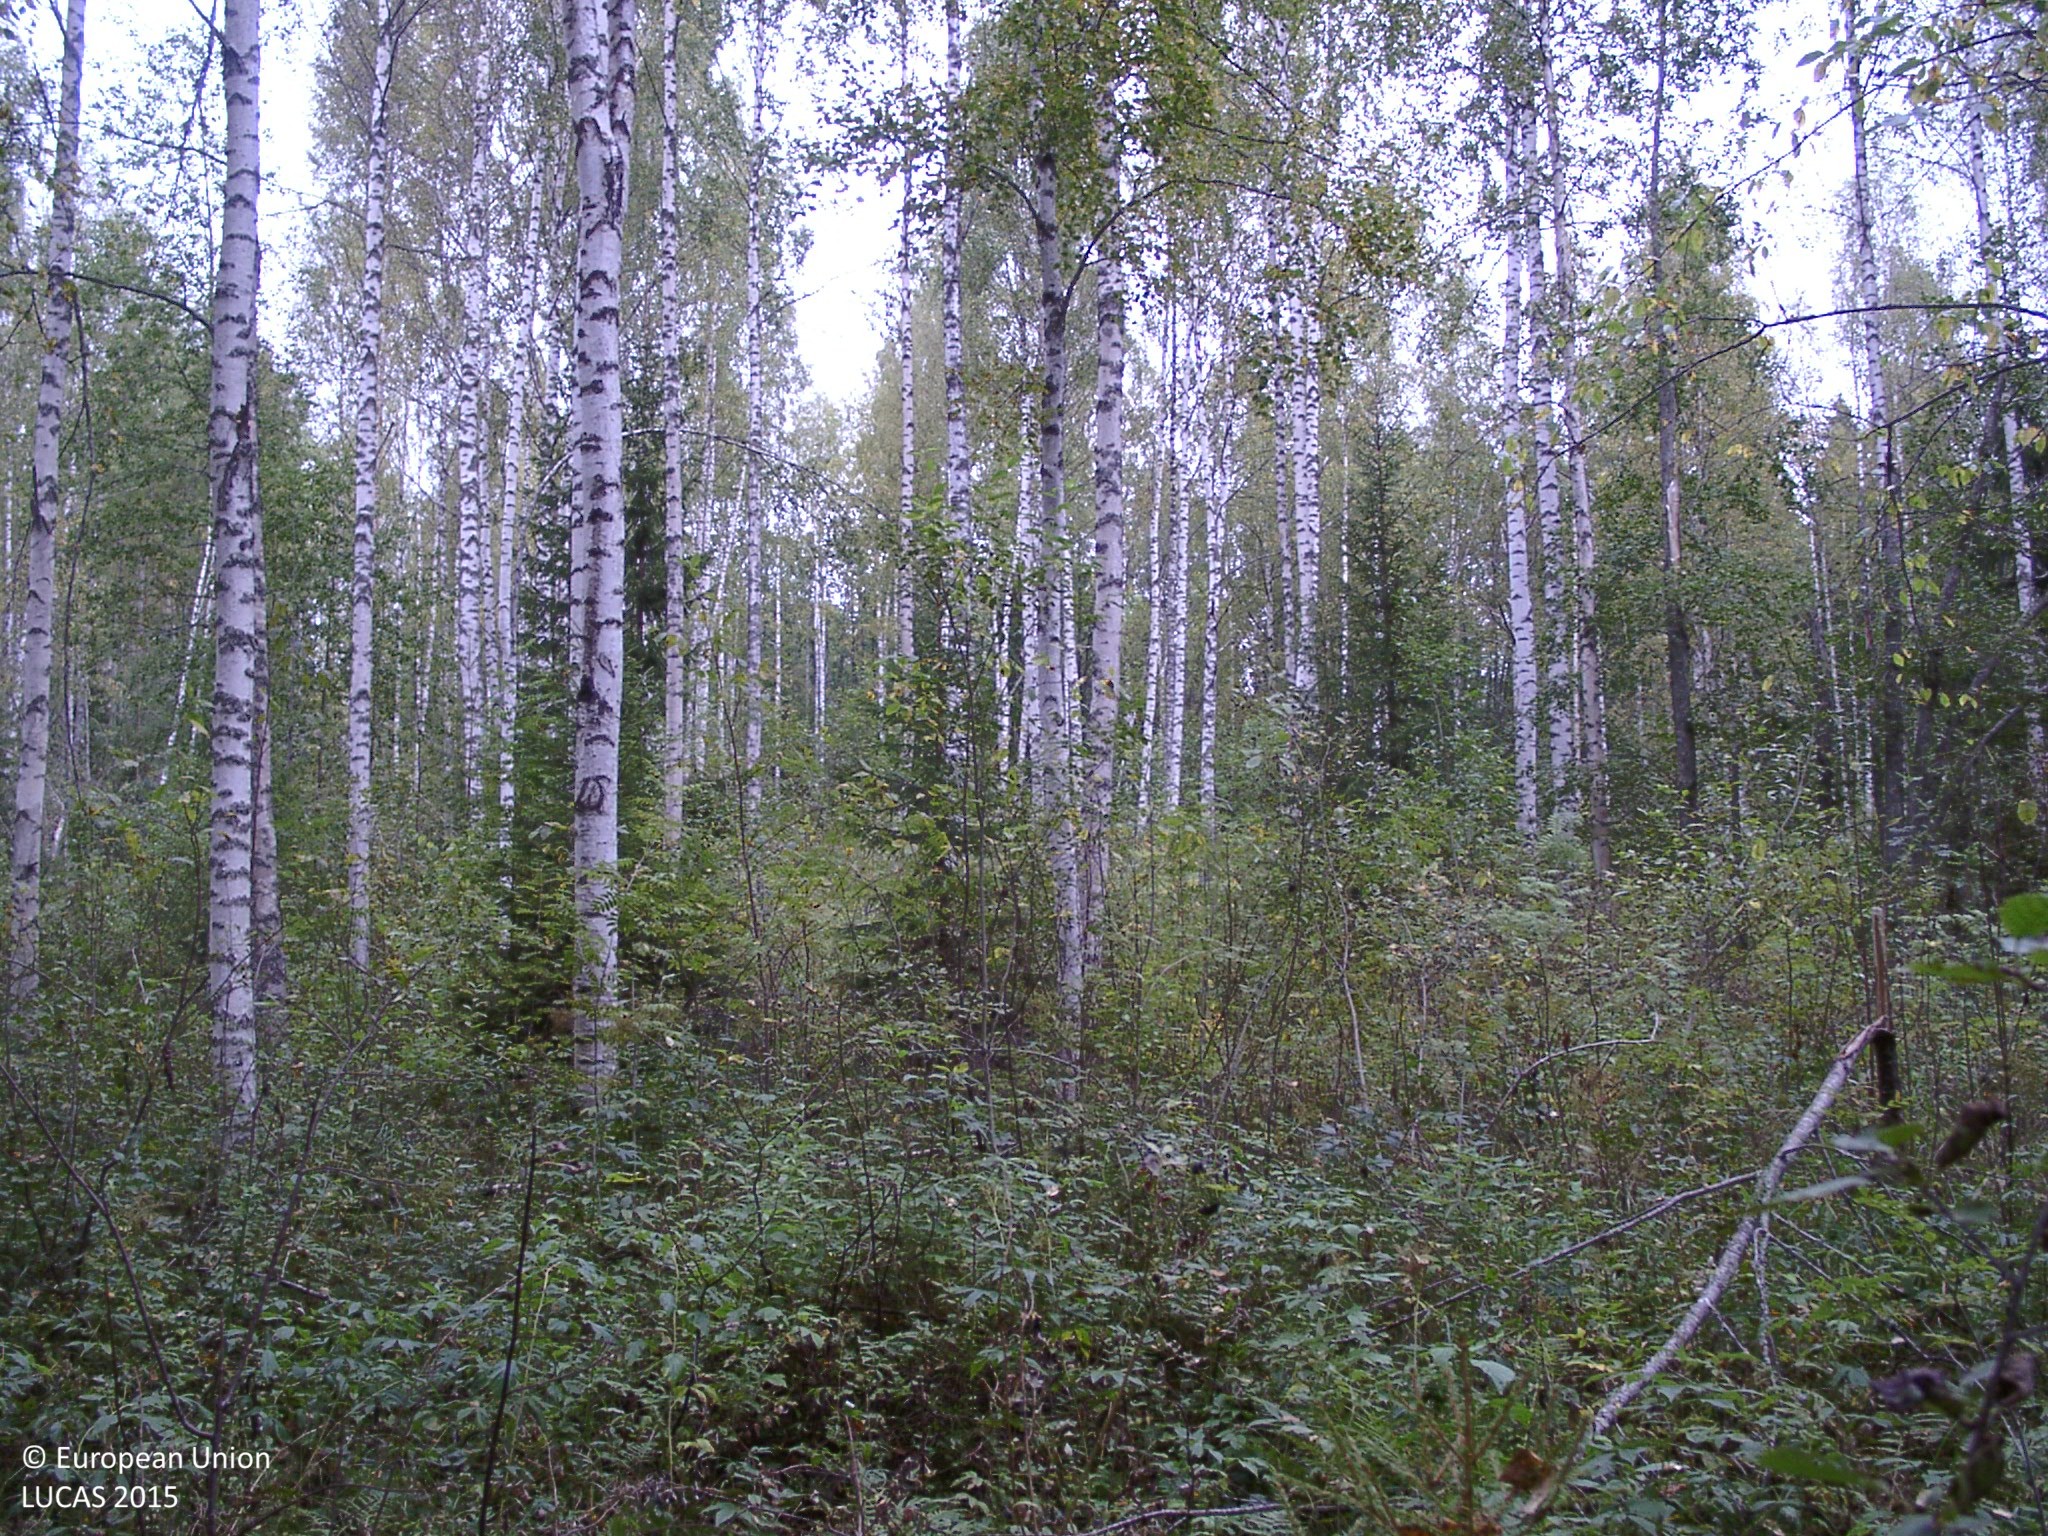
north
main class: Woodland
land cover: Spruce dominated mixed woodland
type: boreal forest
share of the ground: 50 - 75 %
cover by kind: broadleaved forest trees 45 %, coniferous forest trees 25 %, herbaceous plants 15 %, shrubs 5 %, lichens and mosses 5 %, unconsolidated bare surface 5 %
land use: Forestry
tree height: > 5 m
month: September
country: FI
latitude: 62.7596
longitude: 25.1606
